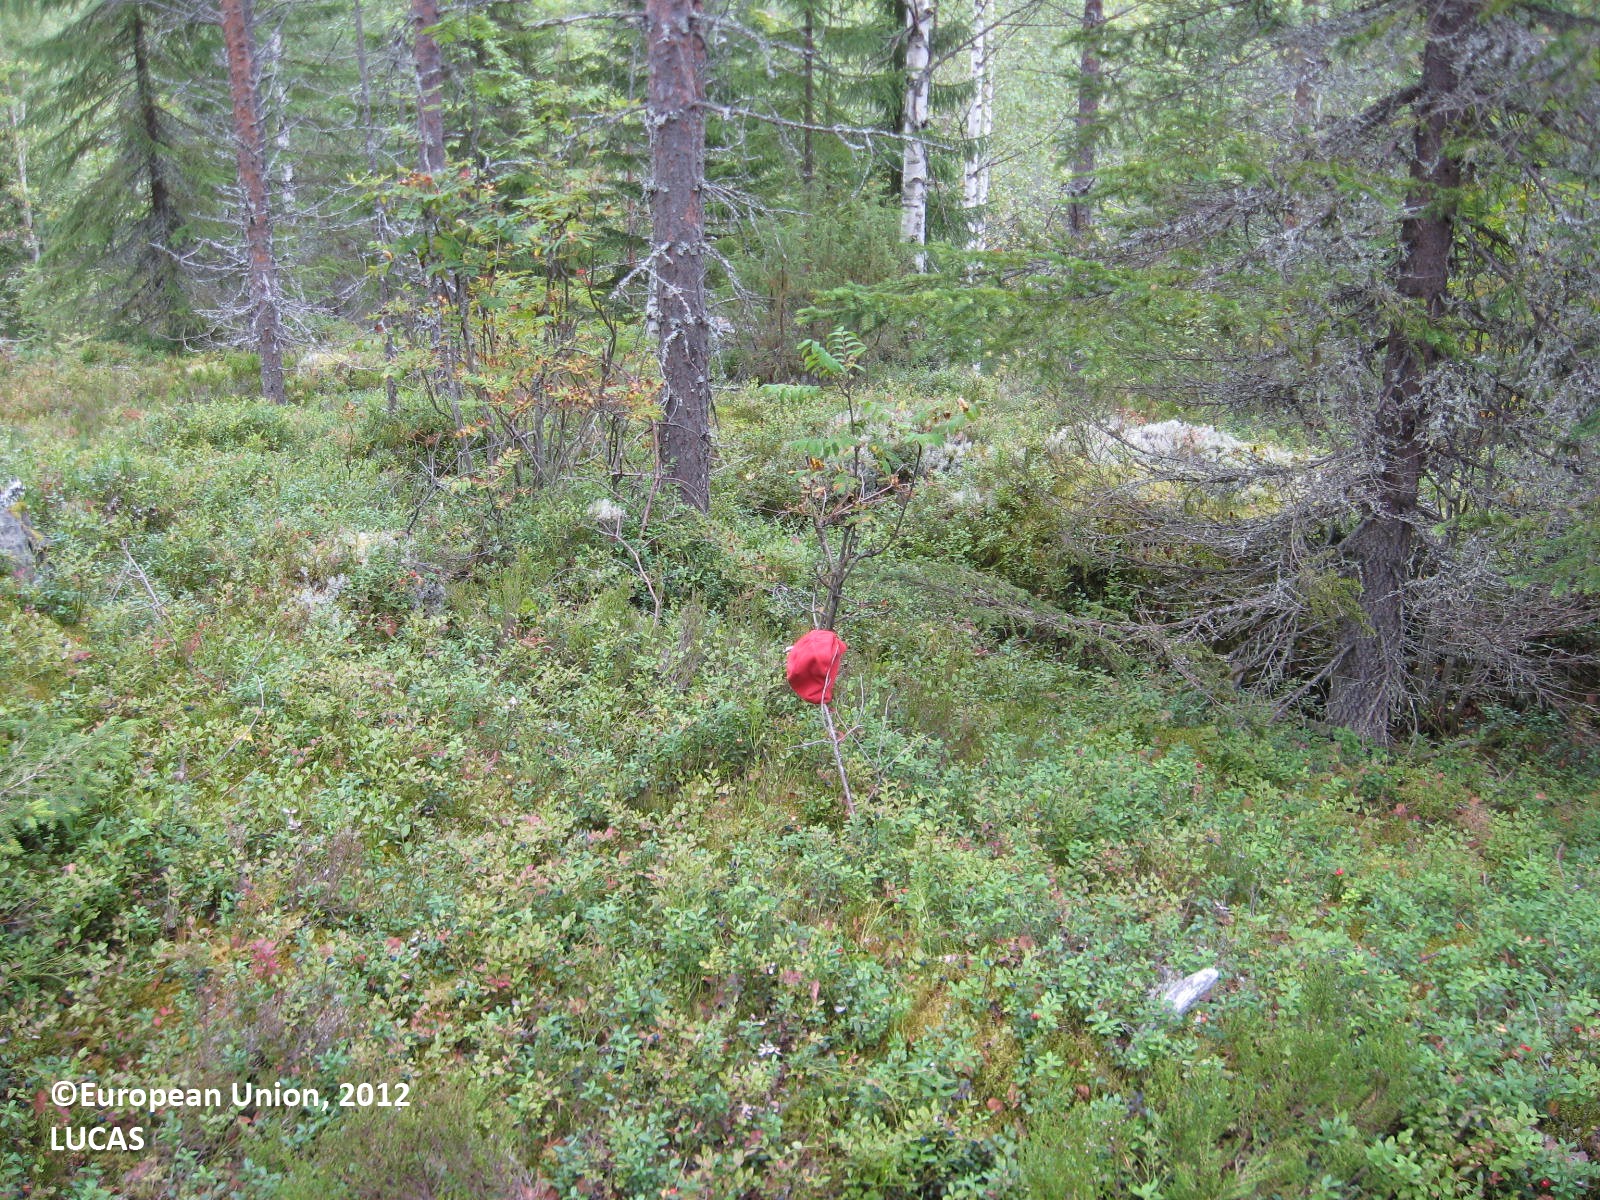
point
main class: Woodland
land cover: Pine dominated mixed woodland
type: boreal forest
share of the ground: > 75 %
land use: Forestry
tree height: > 5 m
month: August
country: FI
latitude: 63.5514
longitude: 29.8623
